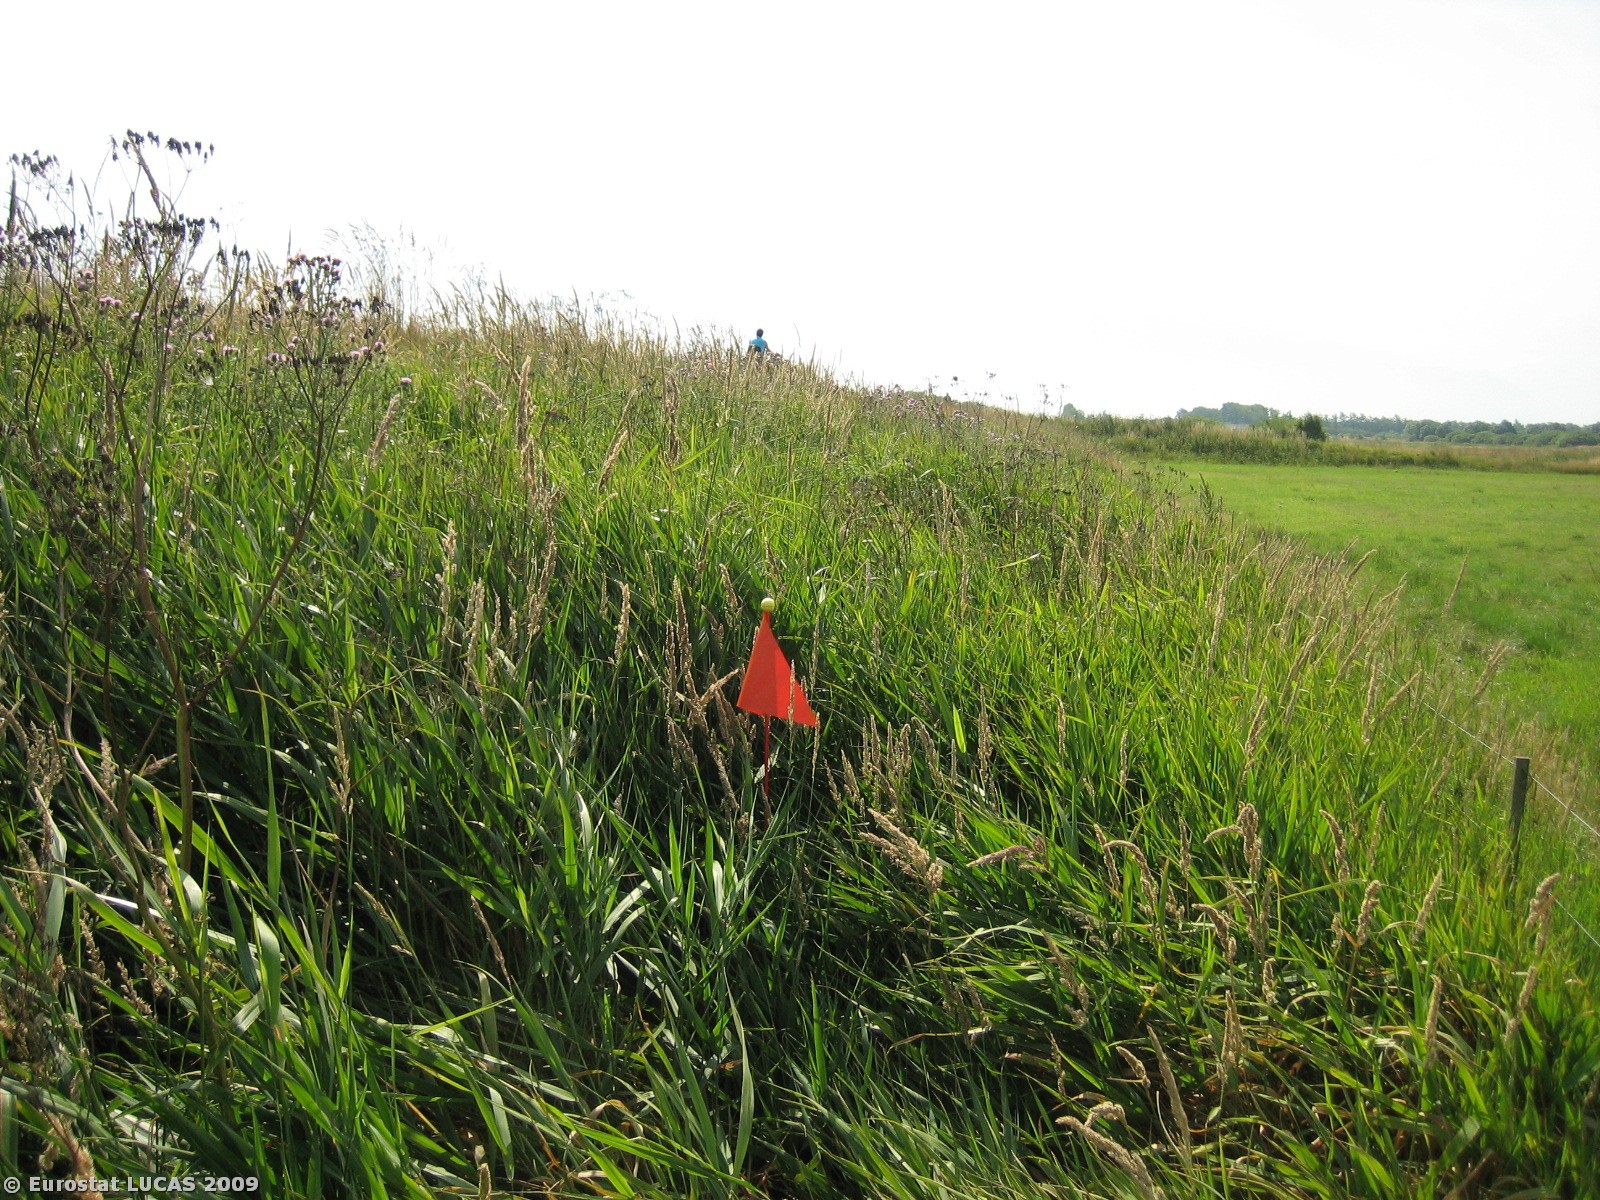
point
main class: Grassland
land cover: Grassland without tree/shrub cover
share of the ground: > 75 %
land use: Nature reserves
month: July
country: DK
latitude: 55.9274
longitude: 8.5131
